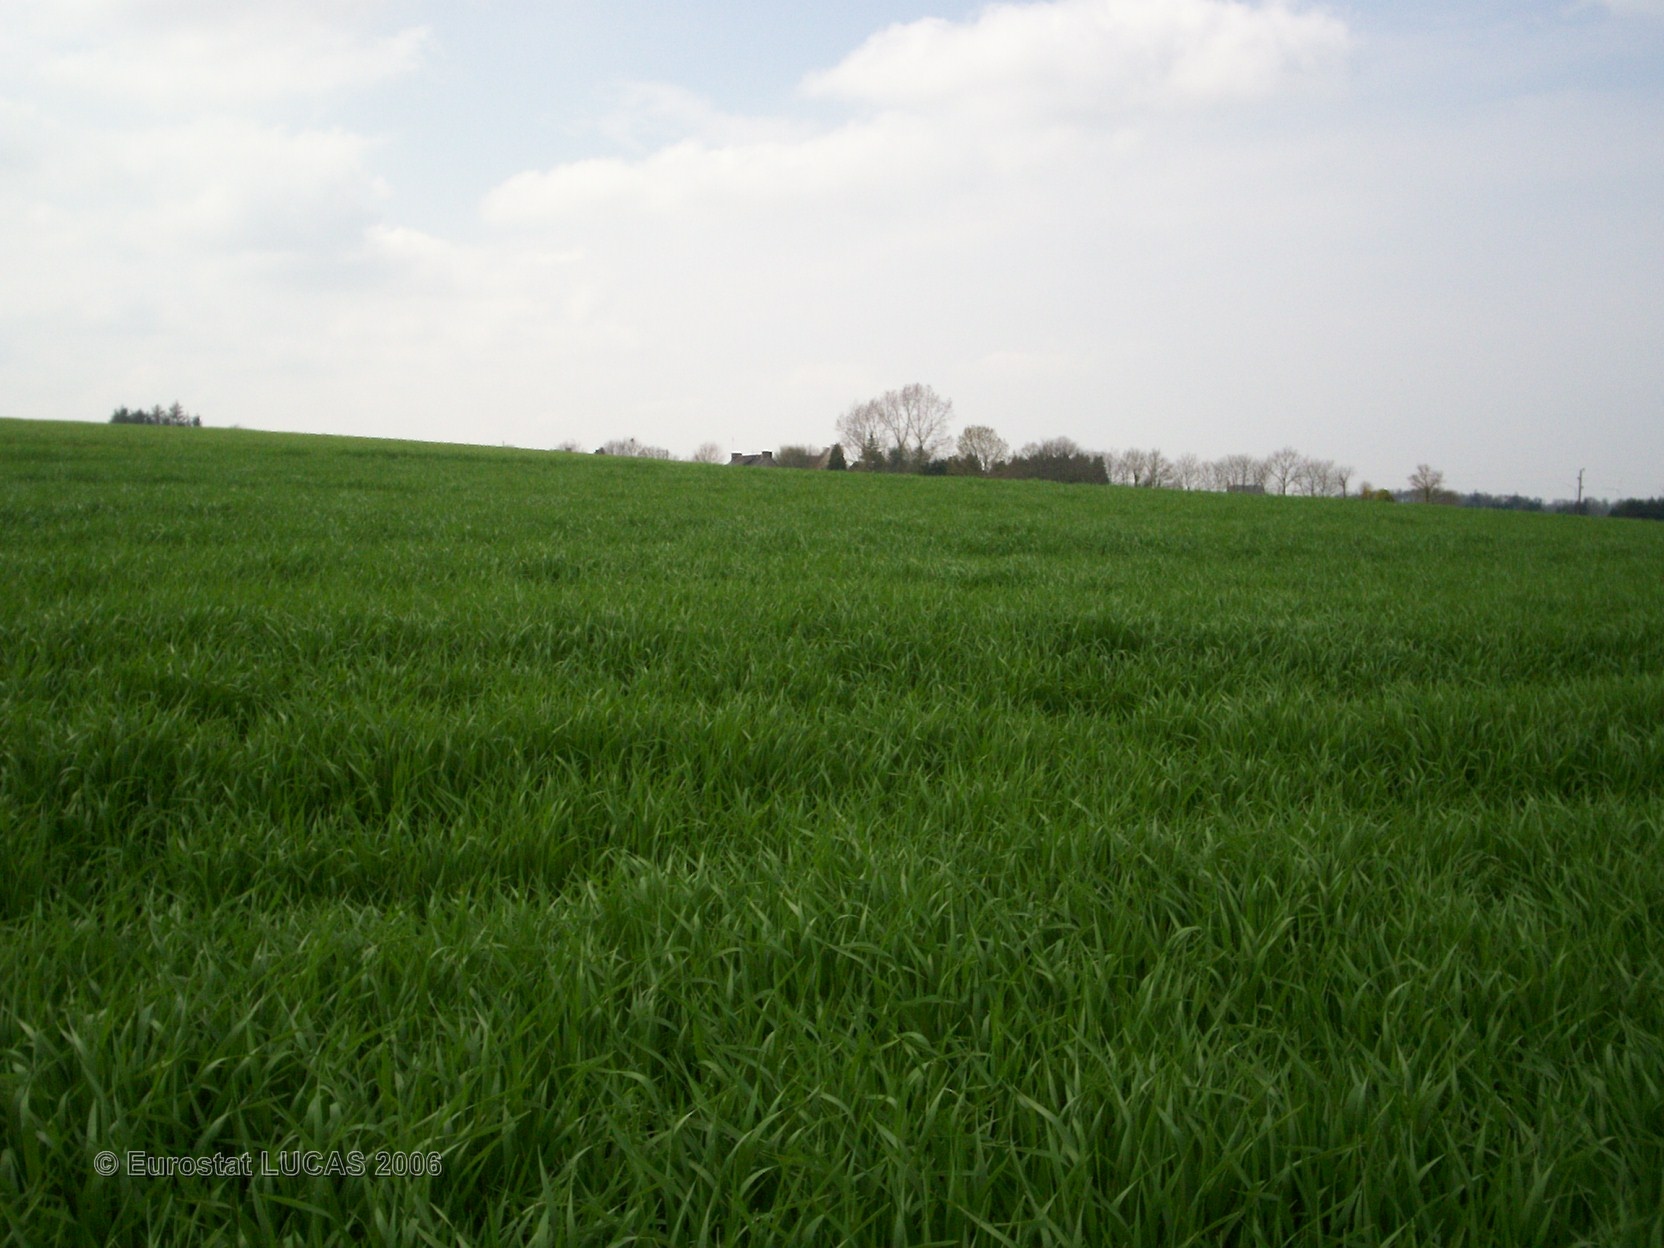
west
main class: Cropland
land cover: Barley
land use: Agriculture (excluding fallow land and kitchen gardens)
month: April
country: FR
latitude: 48.0600
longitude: -2.7712
